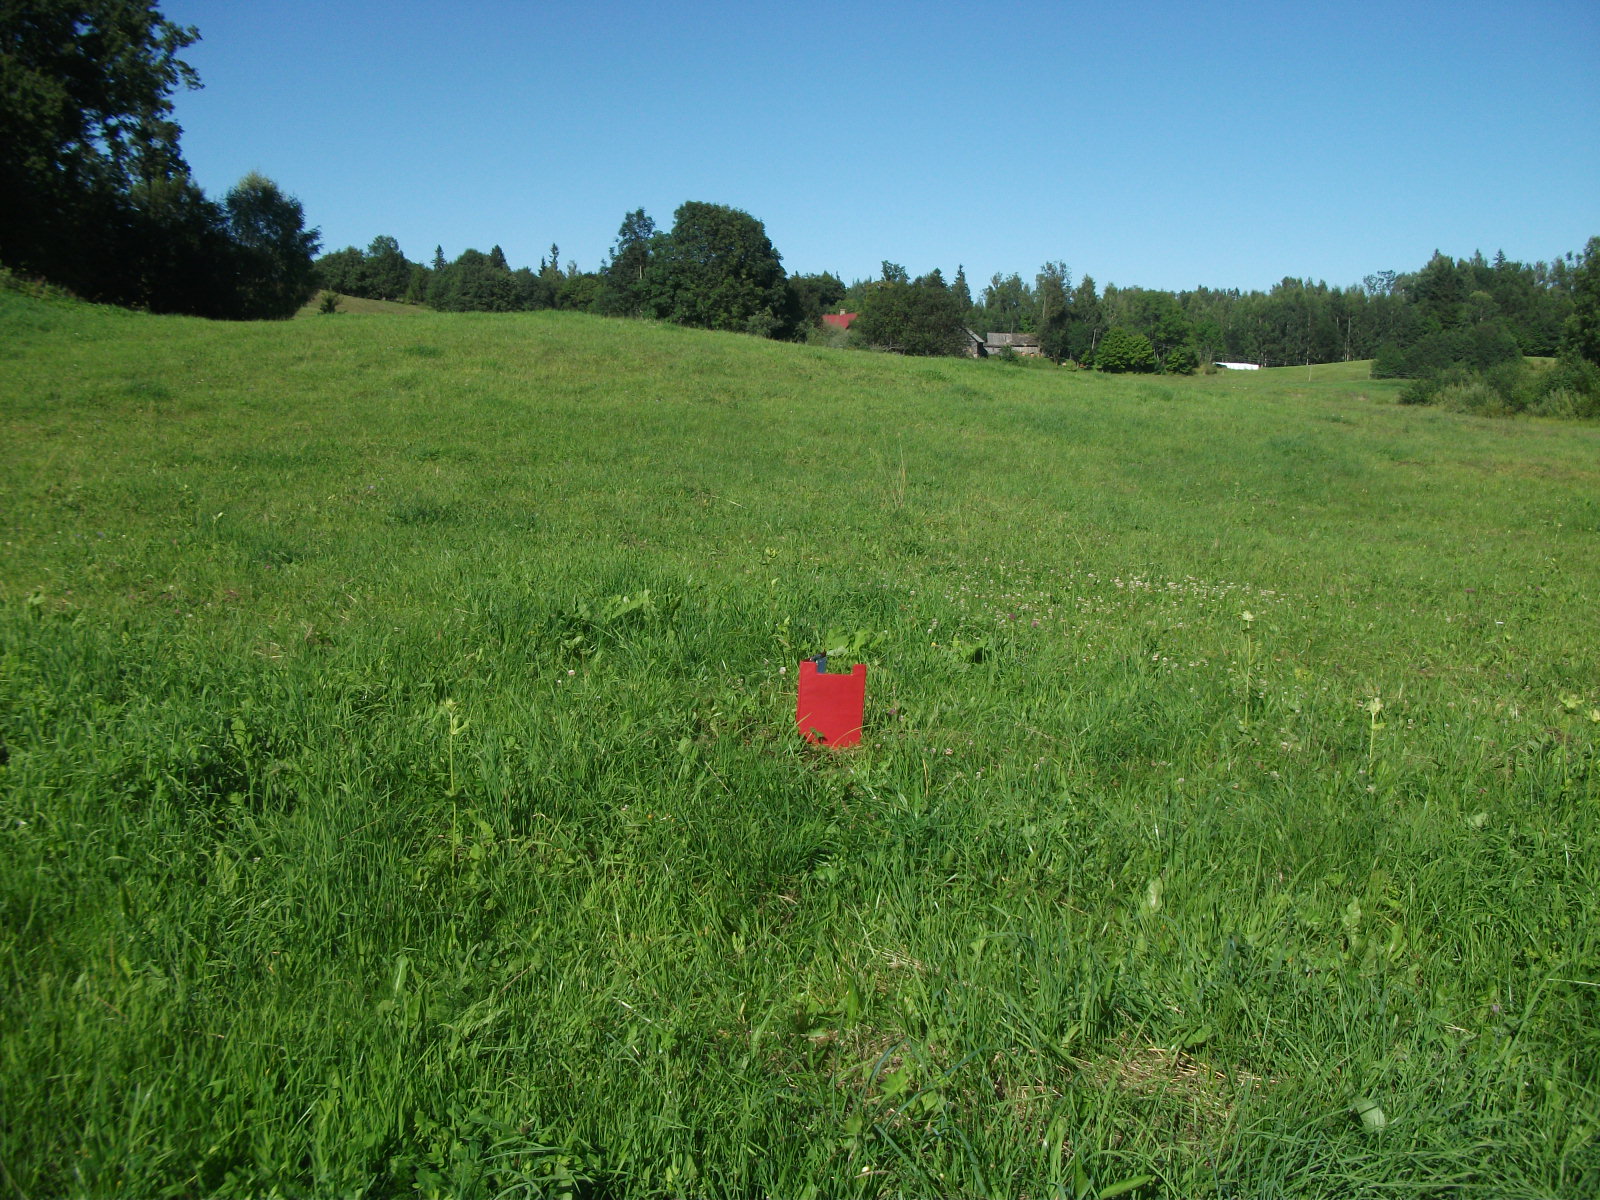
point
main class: Grassland
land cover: Grassland without tree/shrub cover
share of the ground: > 75 %
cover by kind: herbaceous plants 100 %
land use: Agriculture (excluding fallow land and kitchen gardens)
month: August
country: LV
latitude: 56.9249
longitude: 26.2561
